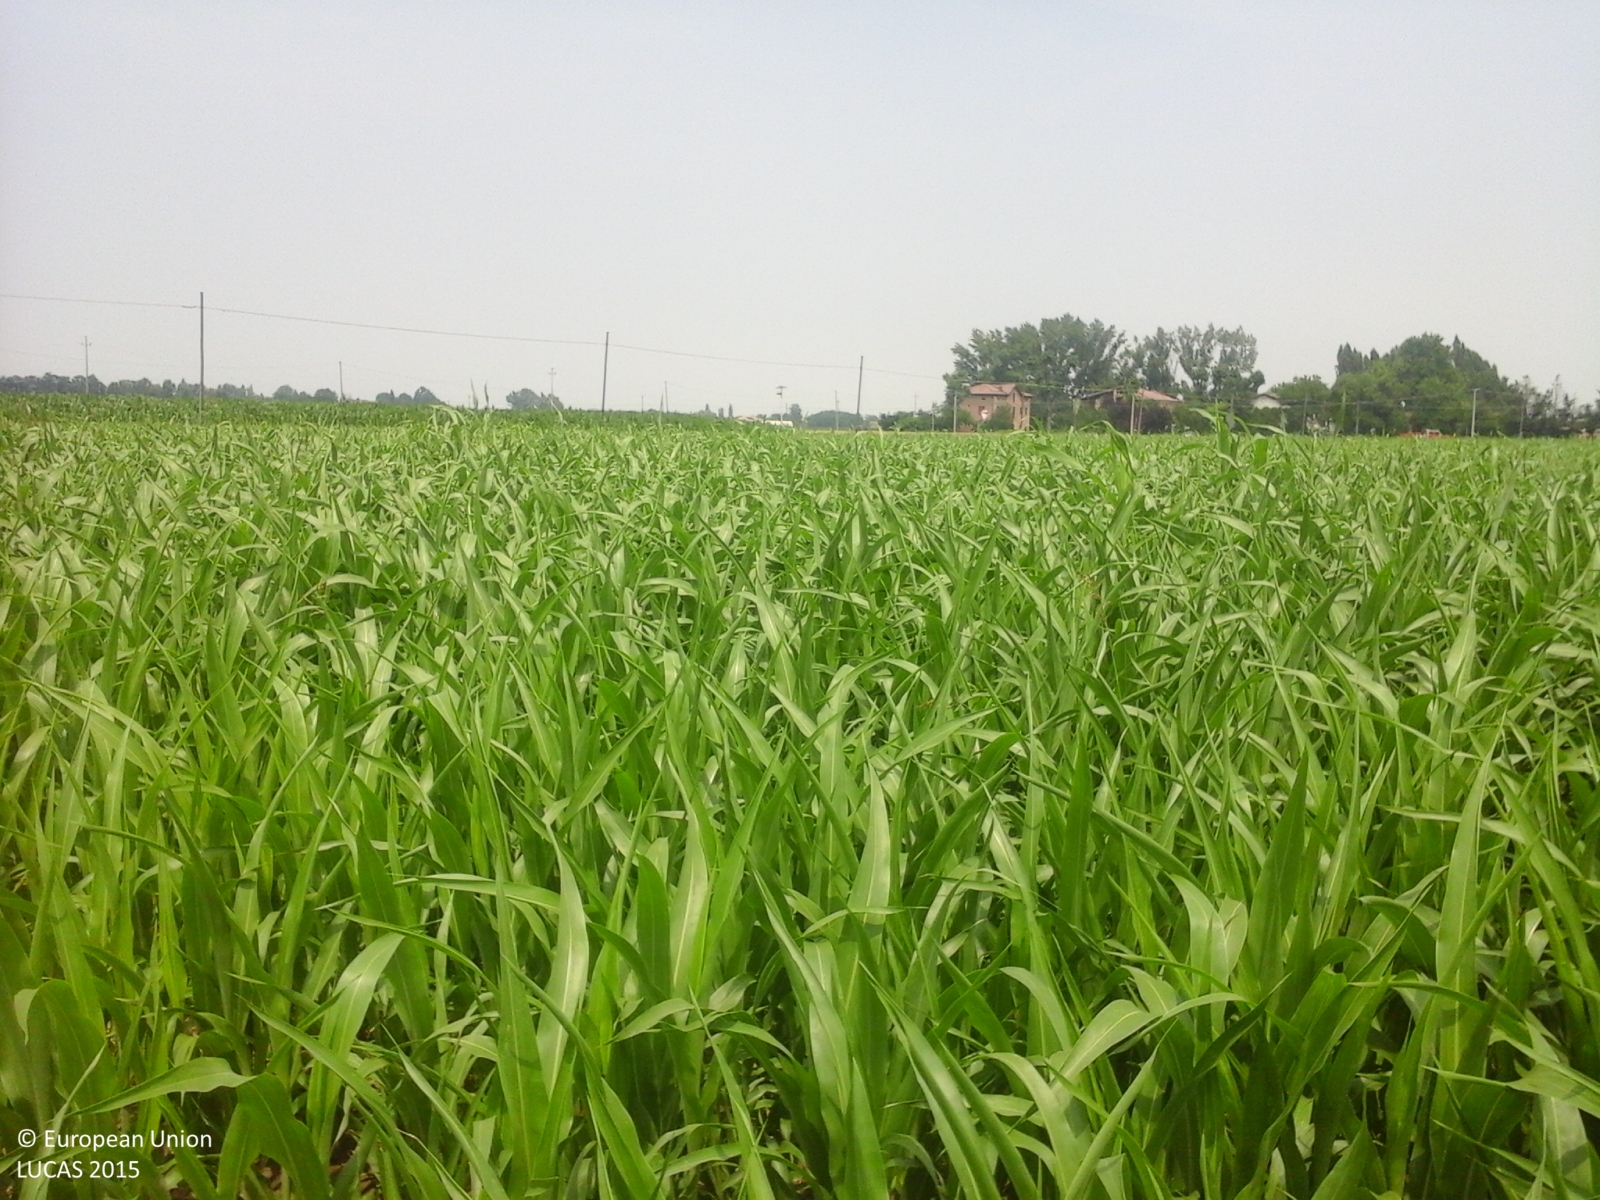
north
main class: Cropland
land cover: Other cereals
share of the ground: > 75 %
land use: Agriculture (excluding fallow land and kitchen gardens)
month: June
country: IT
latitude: 44.7596
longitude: 11.0968
